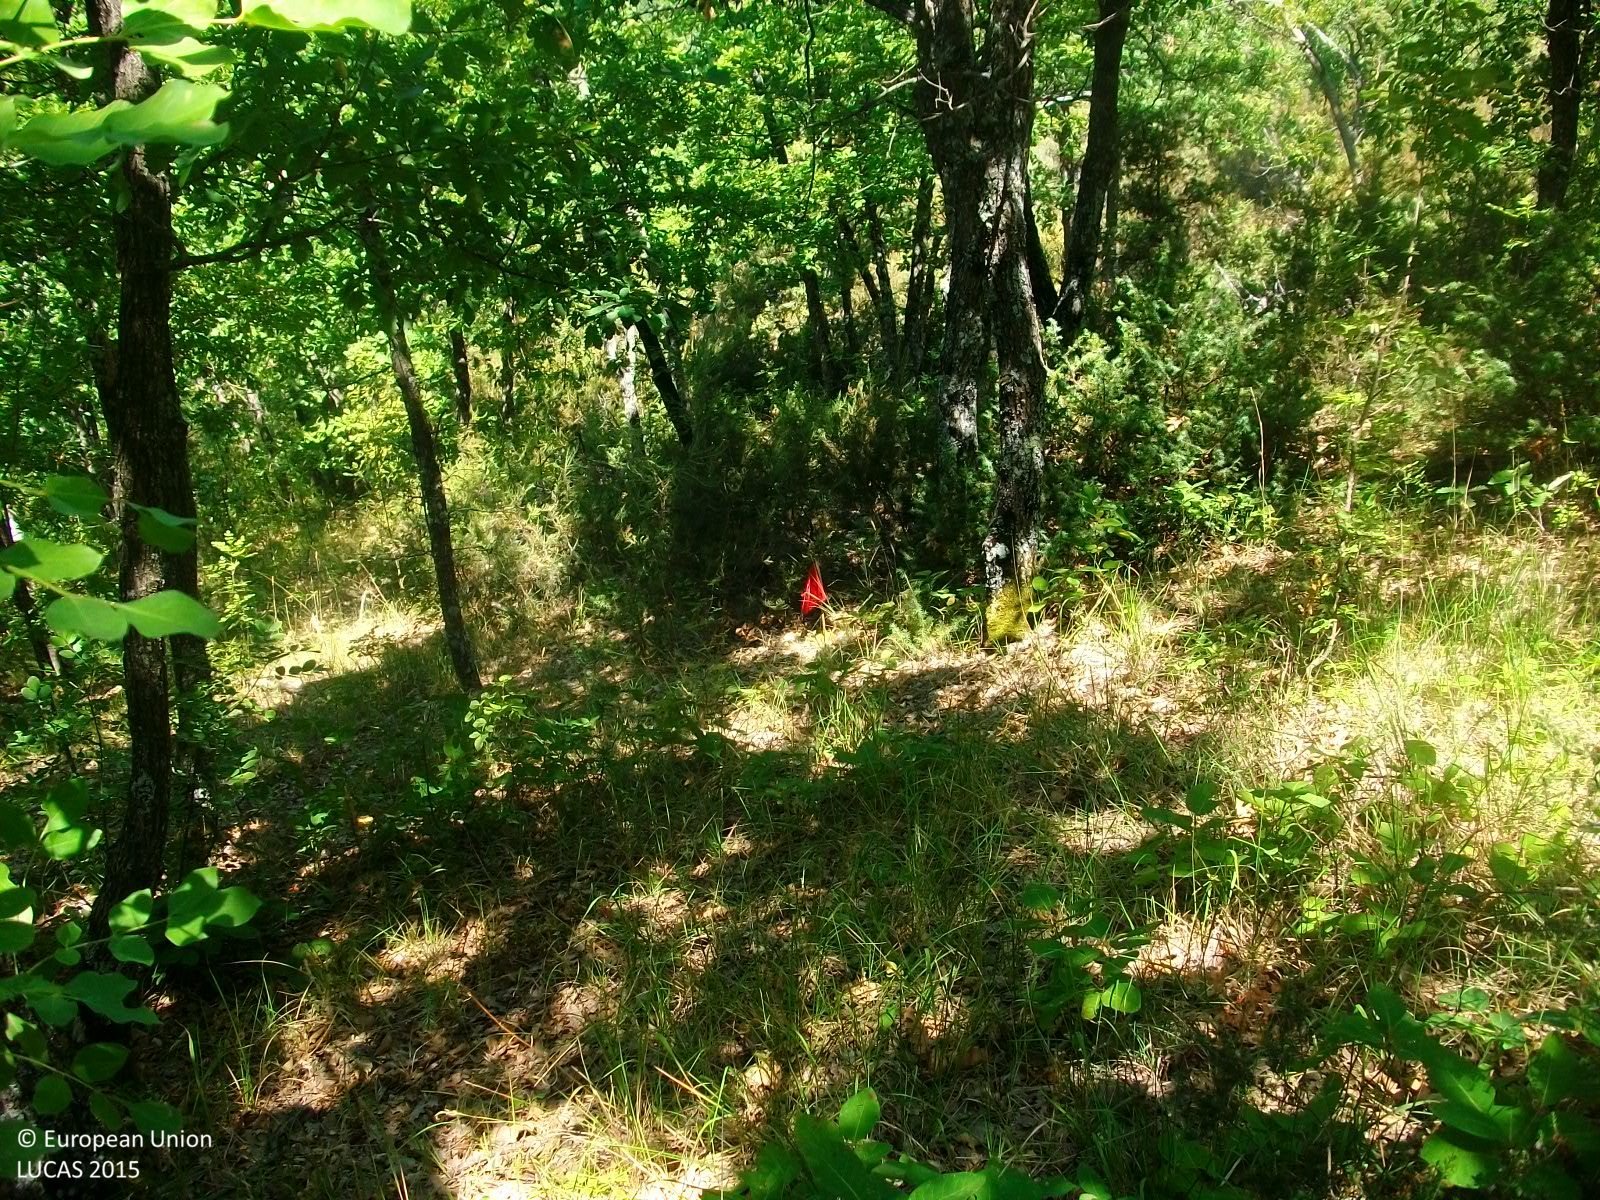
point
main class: Woodland
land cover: Broadleaved woodland
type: thermophilous deciduous forest
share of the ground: > 75 %
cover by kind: broadleaved forest trees 90 %, shrubs 5 %, herbaceous plants 5 %
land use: Forestry
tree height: > 5 m
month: August
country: GR
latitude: 41.2554
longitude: 26.2654
